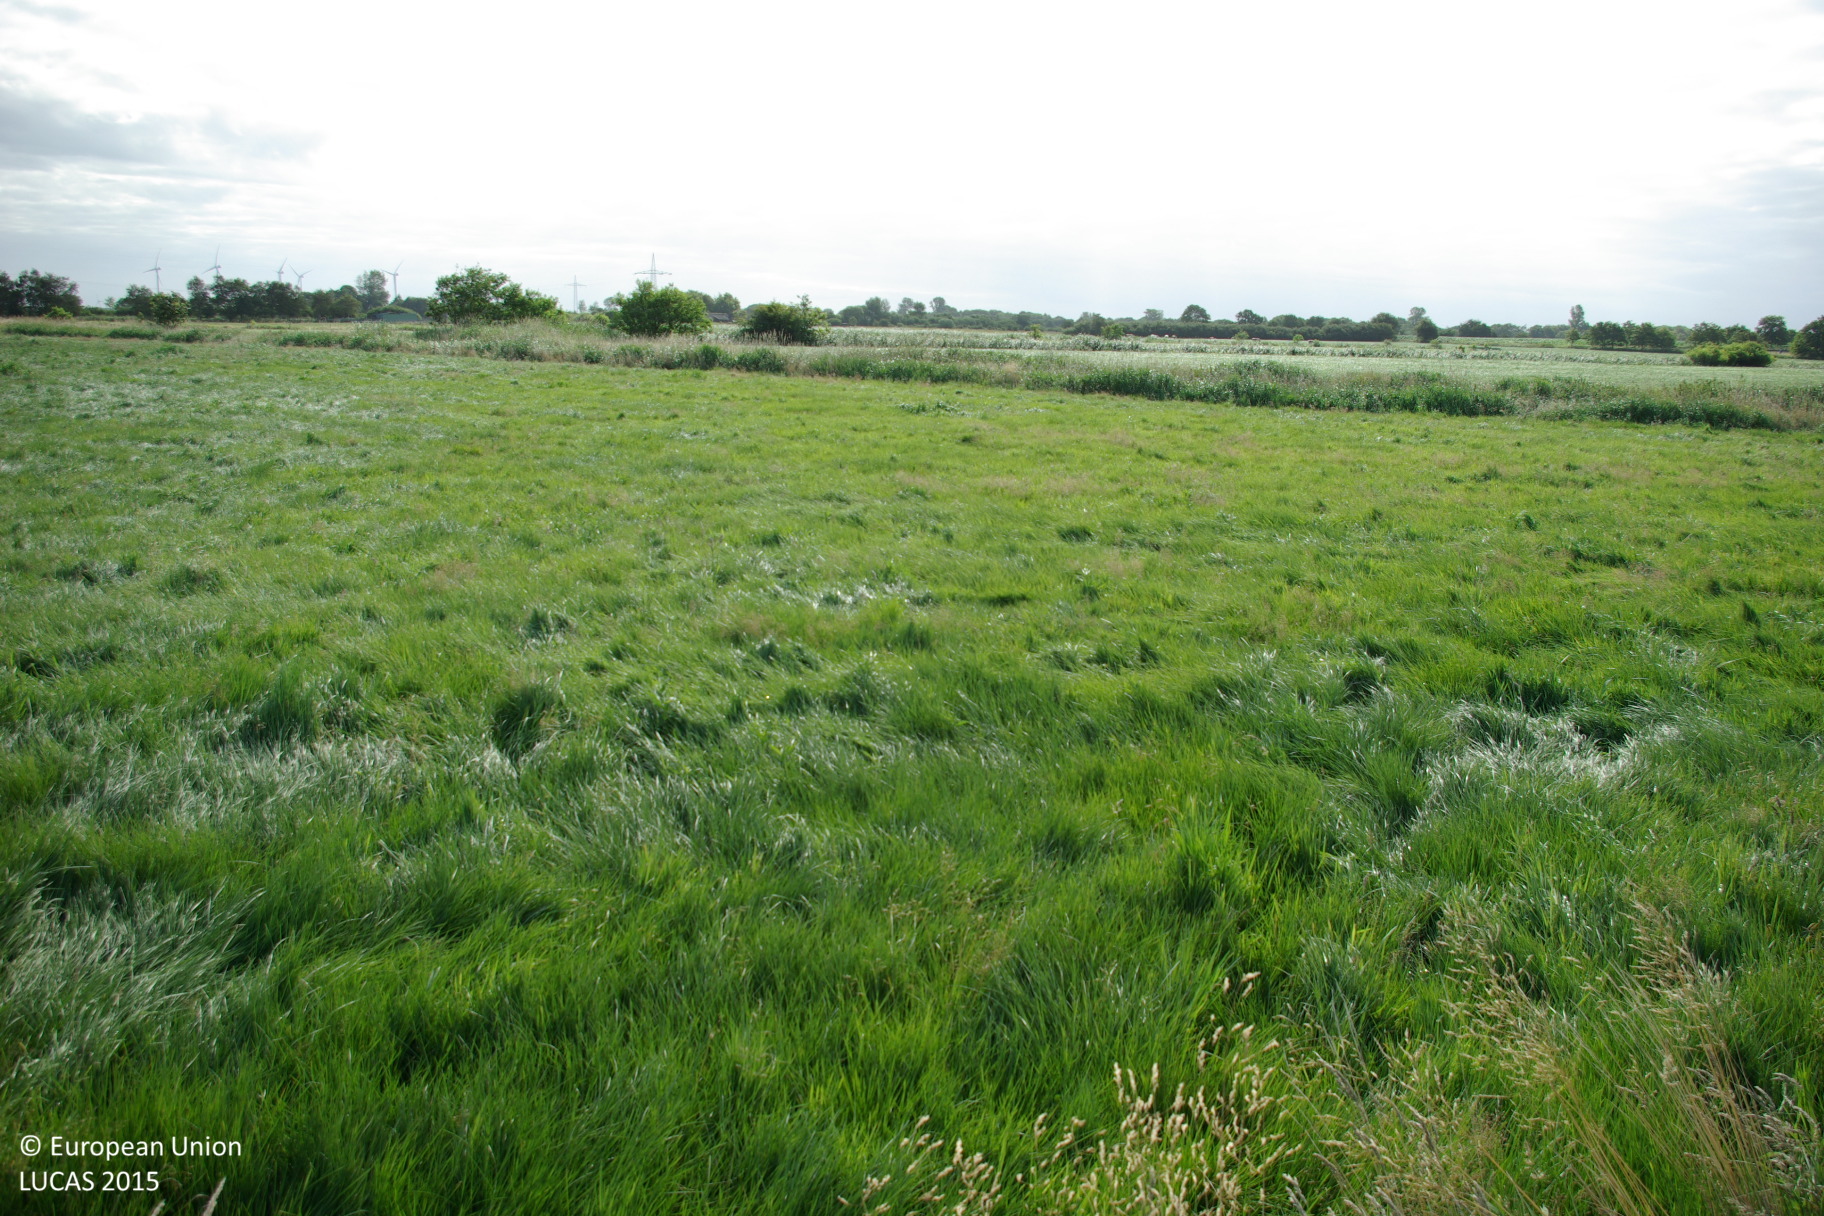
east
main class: Grassland
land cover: Grassland without tree/shrub cover
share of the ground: > 75 %
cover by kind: herbaceous plants 100 %
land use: Agriculture (excluding fallow land and kitchen gardens)
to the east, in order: Shruby margins; Grassland without tree/shrub cover; Spontaneously vegetated surfaces; Inland fresh running water; Spontaneously vegetated surfaces; Grassland without tree/shrub cover; Ponds and wetlands; Ditches and canals; Ponds and wetlands; Grassland without tree/shrub cover; Ditches and canals; Ponds and wetlands; Fences; Grassland without tree/shrub cover; Fences; Shruby margins; Ditches and canals; Shruby margins; Fences; Grassland without tree/shrub cover; Fences; Grassland without tree/shrub cover
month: July
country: DE
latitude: 54.2431
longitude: 9.0645
